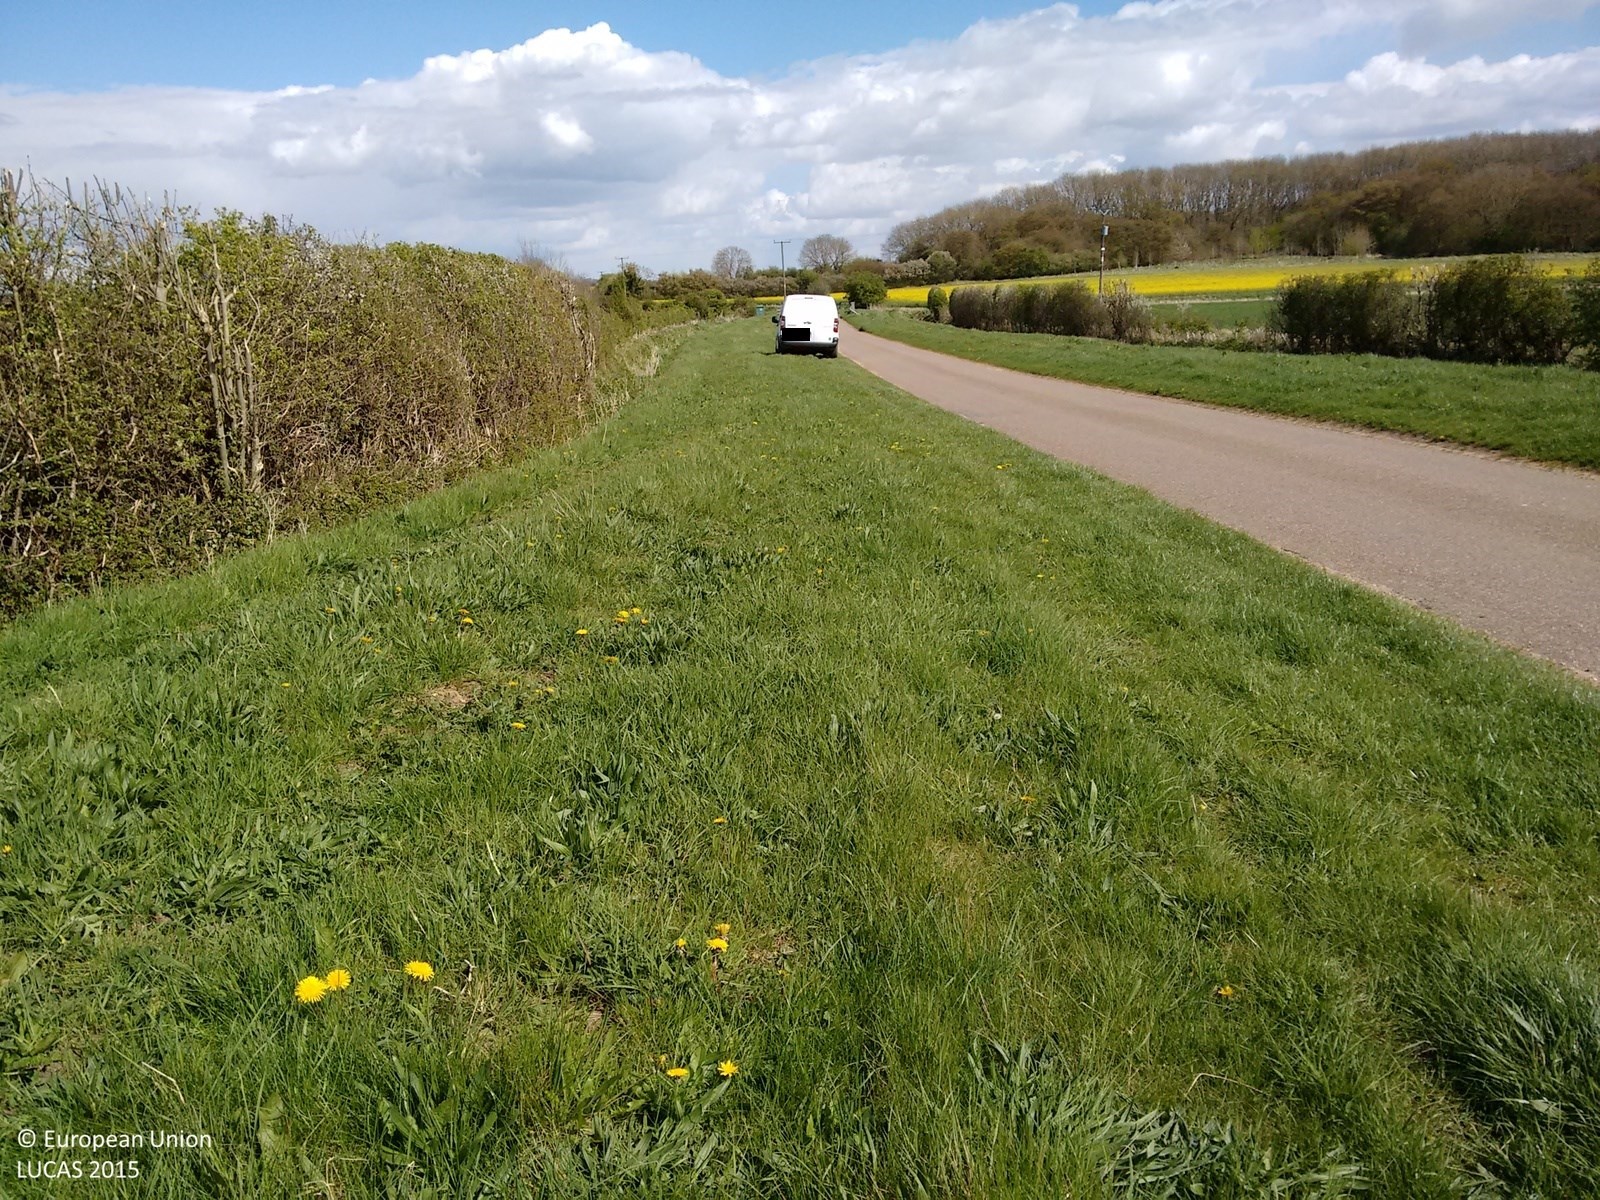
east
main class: Grassland
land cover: Grassland without tree/shrub cover
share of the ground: > 75 %
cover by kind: herbaceous plants 100 %
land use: Road transport
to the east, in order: Grassland without tree/shrub cover; Paved roads, cycling and walking lanes; Grassland without tree/shrub cover; Ditches and canals; Grass margins; Ditches and canals; Grass margins; Electric lines; Tracks; Grass margins; Rape and turnip rape
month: April
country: GB
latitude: 53.1575
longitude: -0.1281
